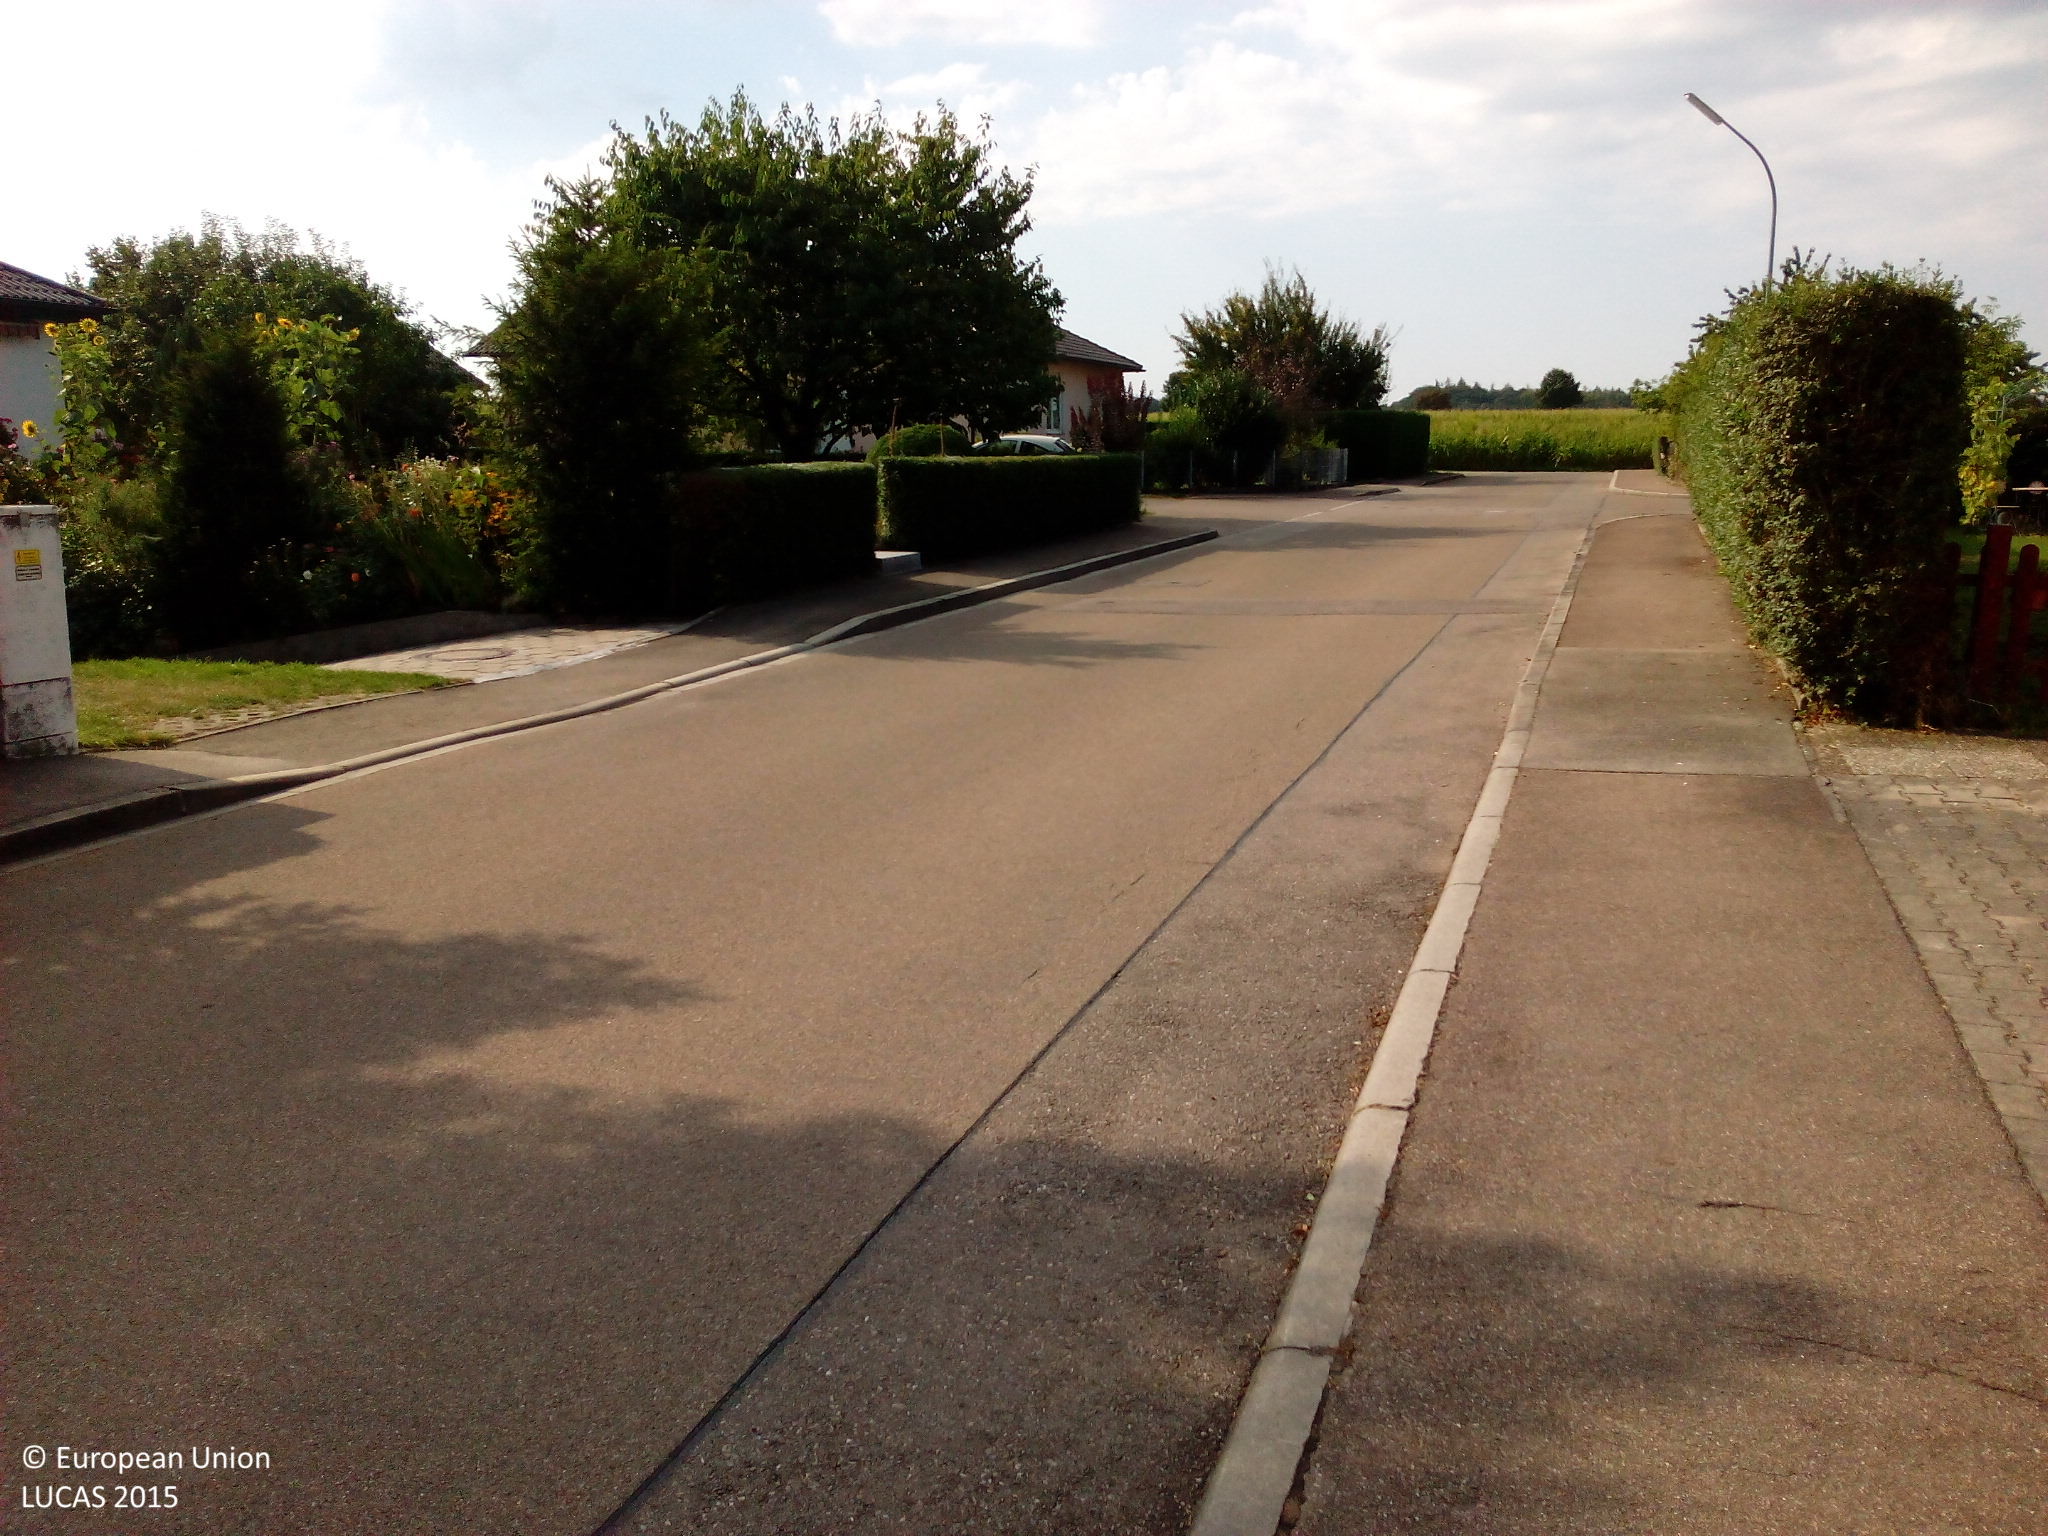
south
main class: Grassland
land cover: Grassland without tree/shrub cover
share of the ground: > 75 %
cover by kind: herbaceous plants 100 %
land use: Residential
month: August
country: DE
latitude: 48.4570
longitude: 10.3108
